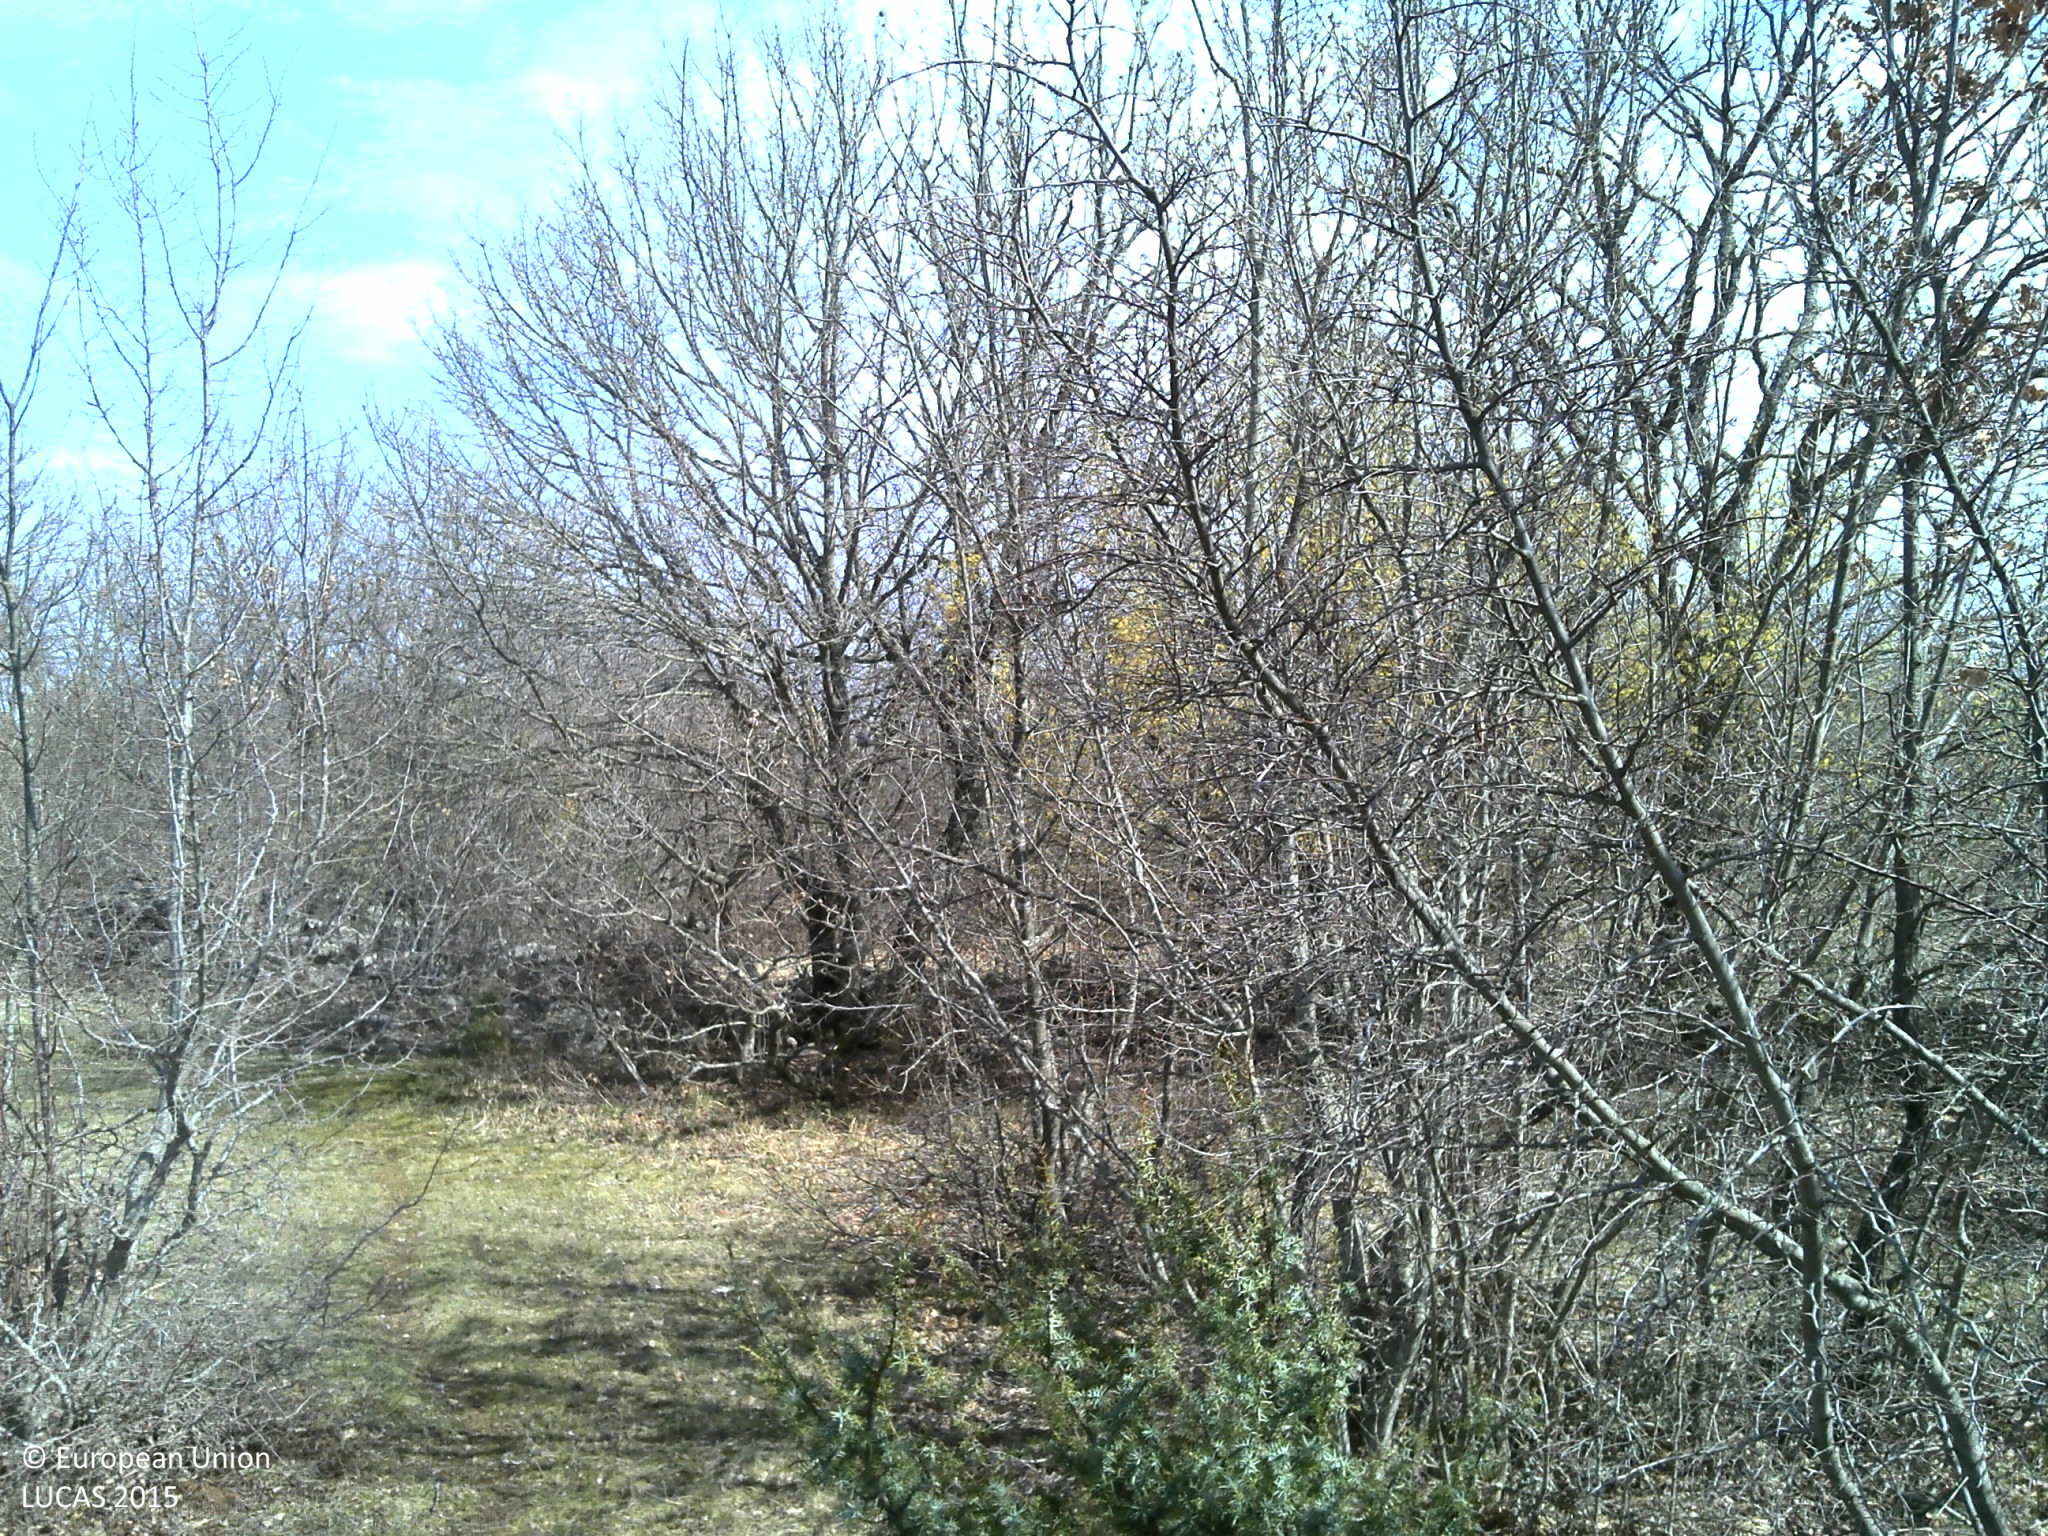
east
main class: Woodland
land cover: Broadleaved woodland
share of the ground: 25 - 50 %
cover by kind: broadleaved forest trees 40 %, herbaceous plants 35 %, lichens and mosses 10 %, unconsolidated bare surface 10 %, consolidated bare surface 5 %
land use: Agriculture (excluding fallow land and kitchen gardens)
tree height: > 5 m
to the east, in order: Broadleaved woodland; Dry stone walls; Broadleaved woodland; Dry stone walls; Broadleaved woodland; Dry stone walls; Spontaneously vegetated surfaces; Dry stone walls; Broadleaved woodland; Shrubland with sparse tree cover; Paved roads, cycling and walking lanes; Broadleaved woodland
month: March
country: HR
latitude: 44.0397
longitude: 15.8698
